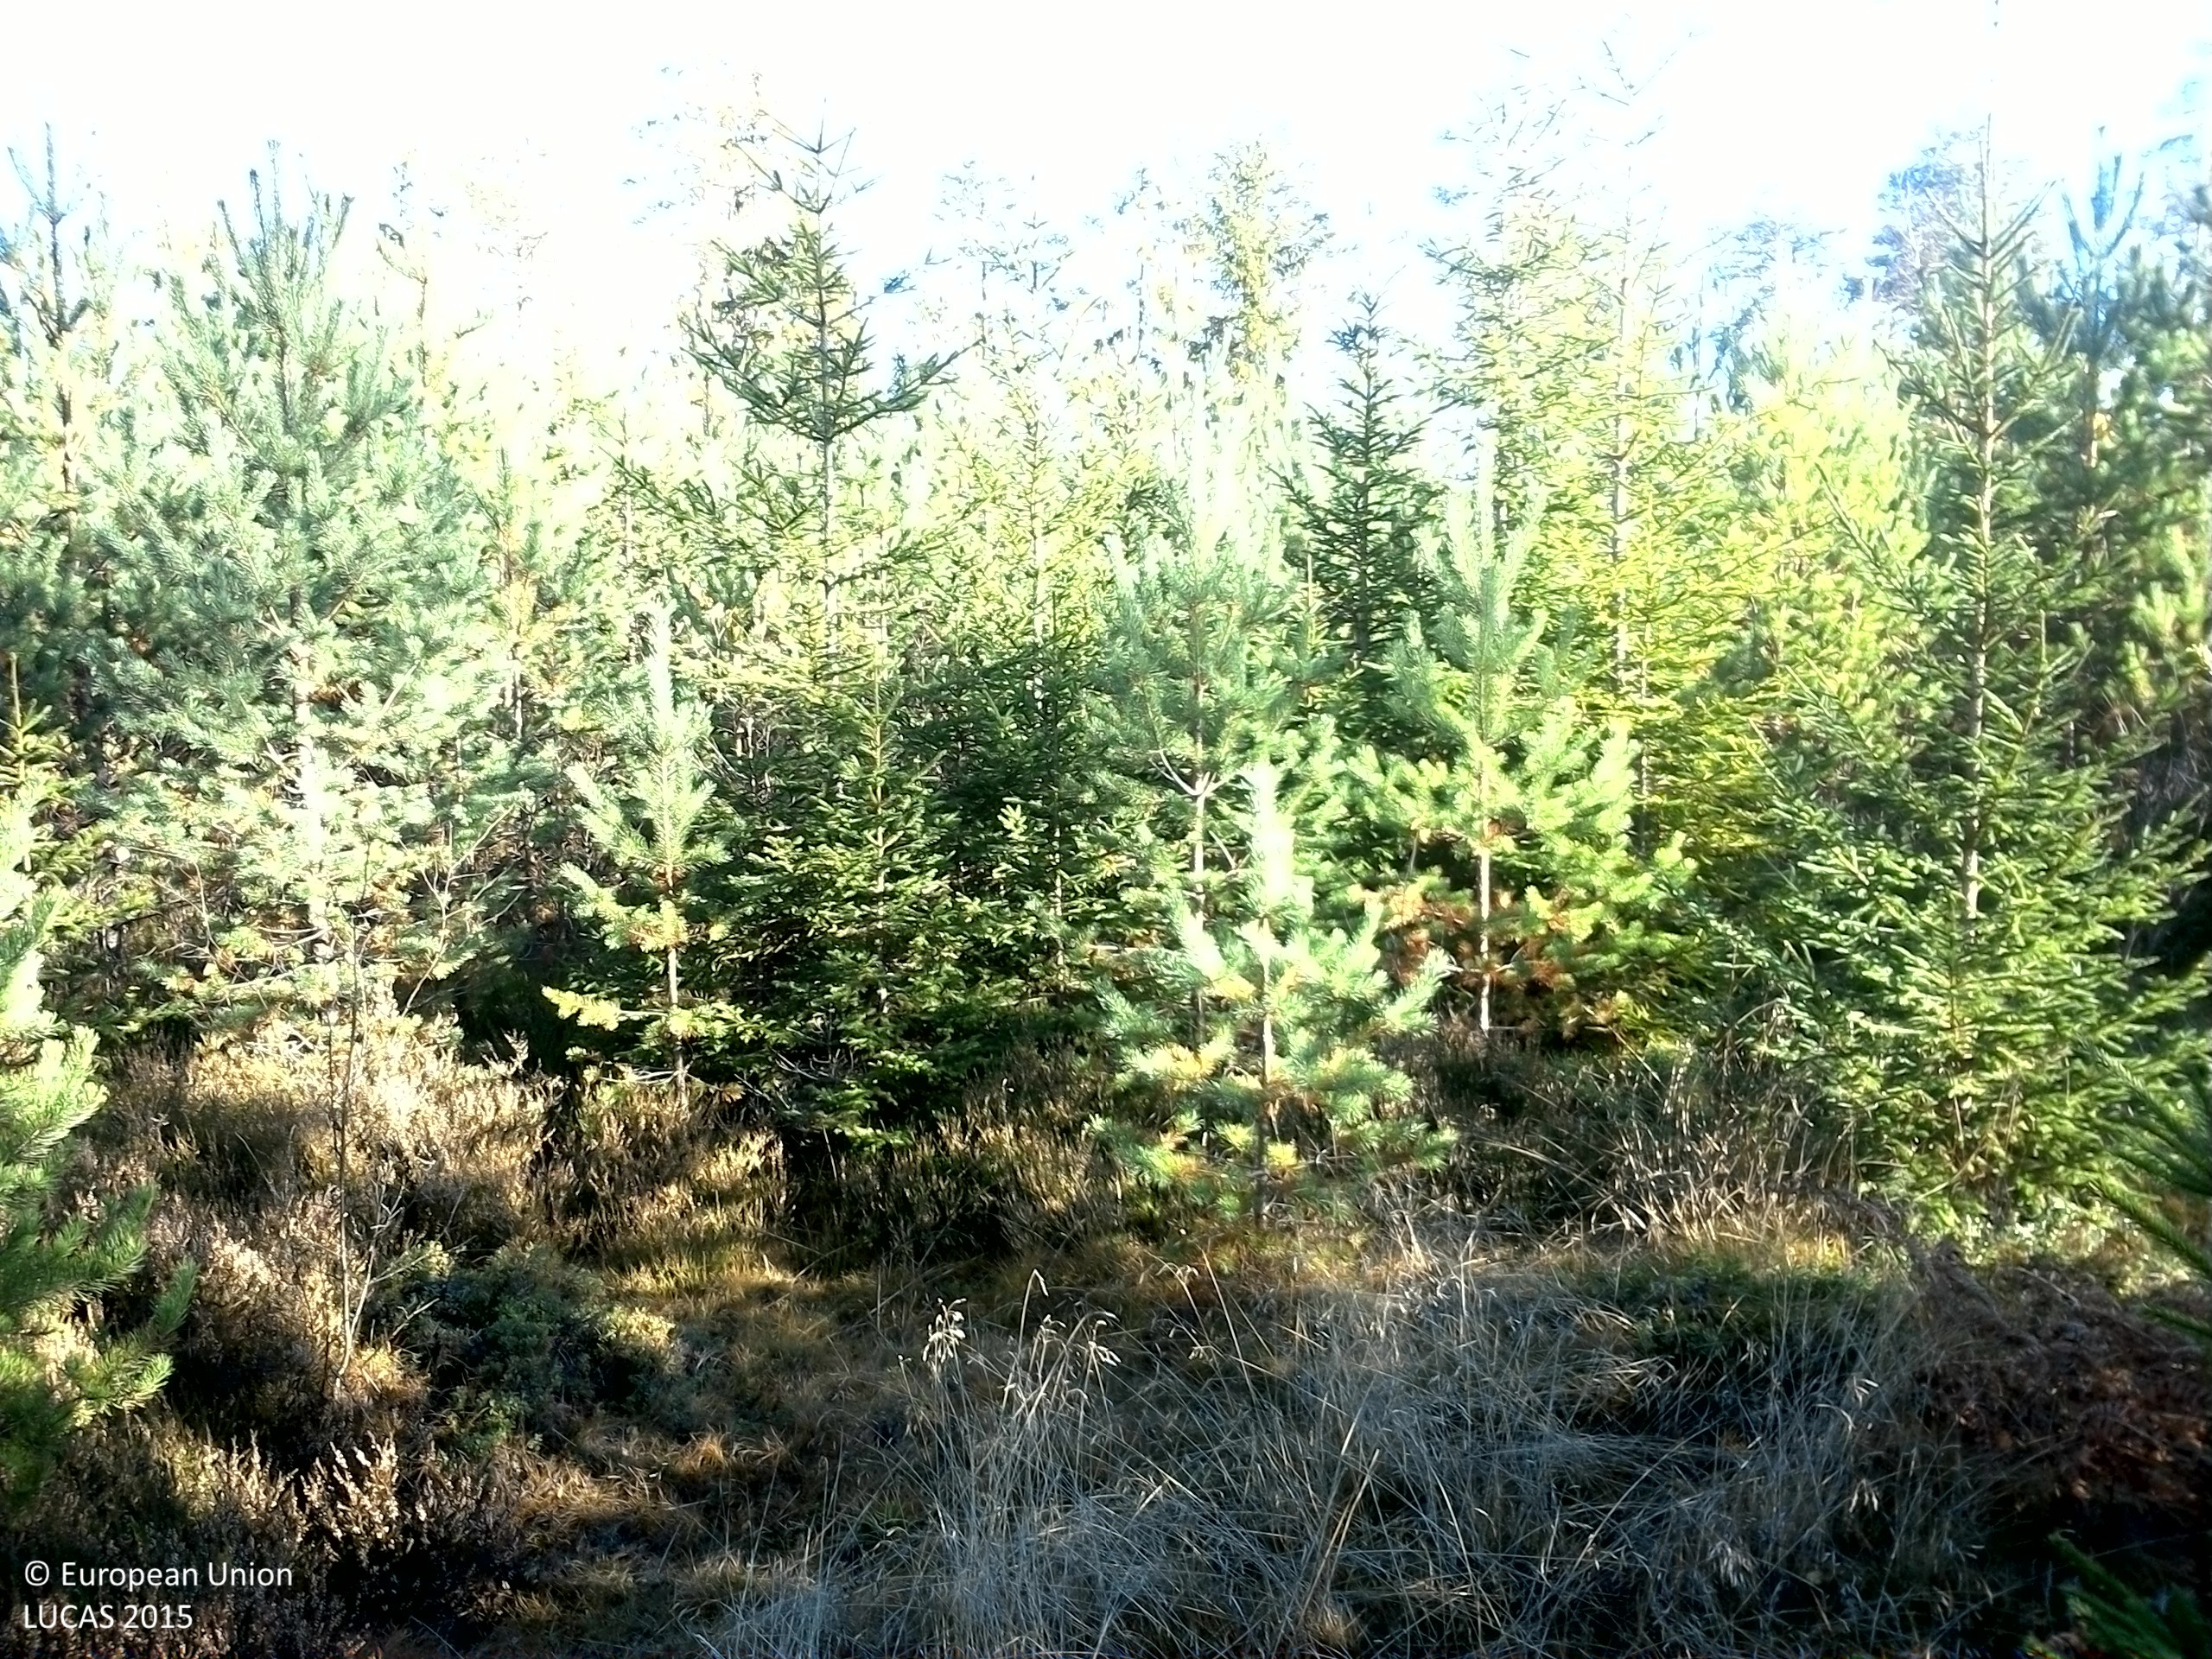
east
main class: Woodland
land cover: Pine dominated coniferous woodland
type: boreal forest
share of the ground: 50 - 75 %
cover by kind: coniferous forest trees 60 %, shrubs 20 %, herbaceous plants 15 %, lichens and mosses 5 %
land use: Forestry
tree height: < 5 m
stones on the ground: 10 - 25 %
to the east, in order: Pine dominated coniferous woodland; Spruce dominated coniferous woodland; Ditches and canals; Spruce dominated coniferous woodland; Pine dominated coniferous woodland; Shrubland with sparse tree cover; Paved roads, cycling and walking lanes; Pine dominated coniferous woodland
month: October
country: SE
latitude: 59.5381
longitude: 14.8539
